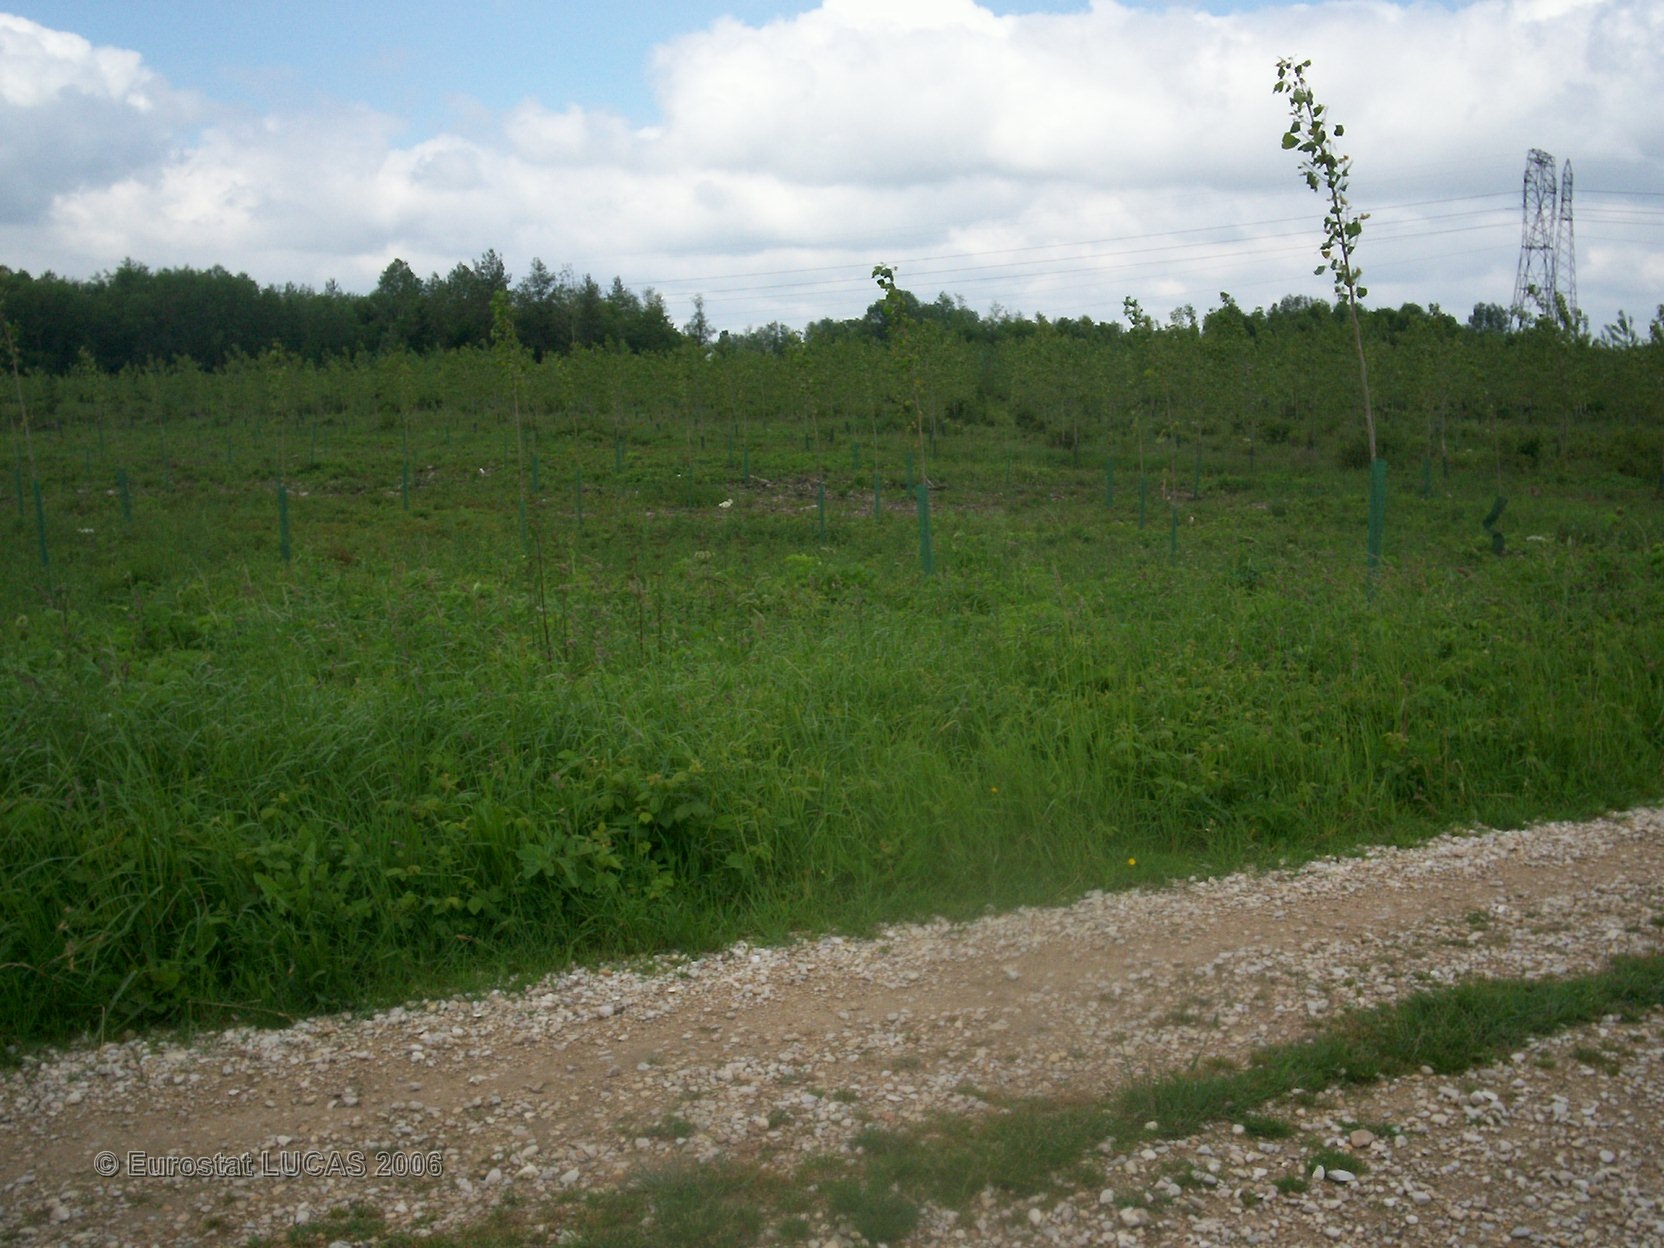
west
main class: Cropland
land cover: Rape and turnip rape
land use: Agriculture (excluding fallow land and kitchen gardens)
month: June
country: FR
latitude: 48.5736
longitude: 4.5080
